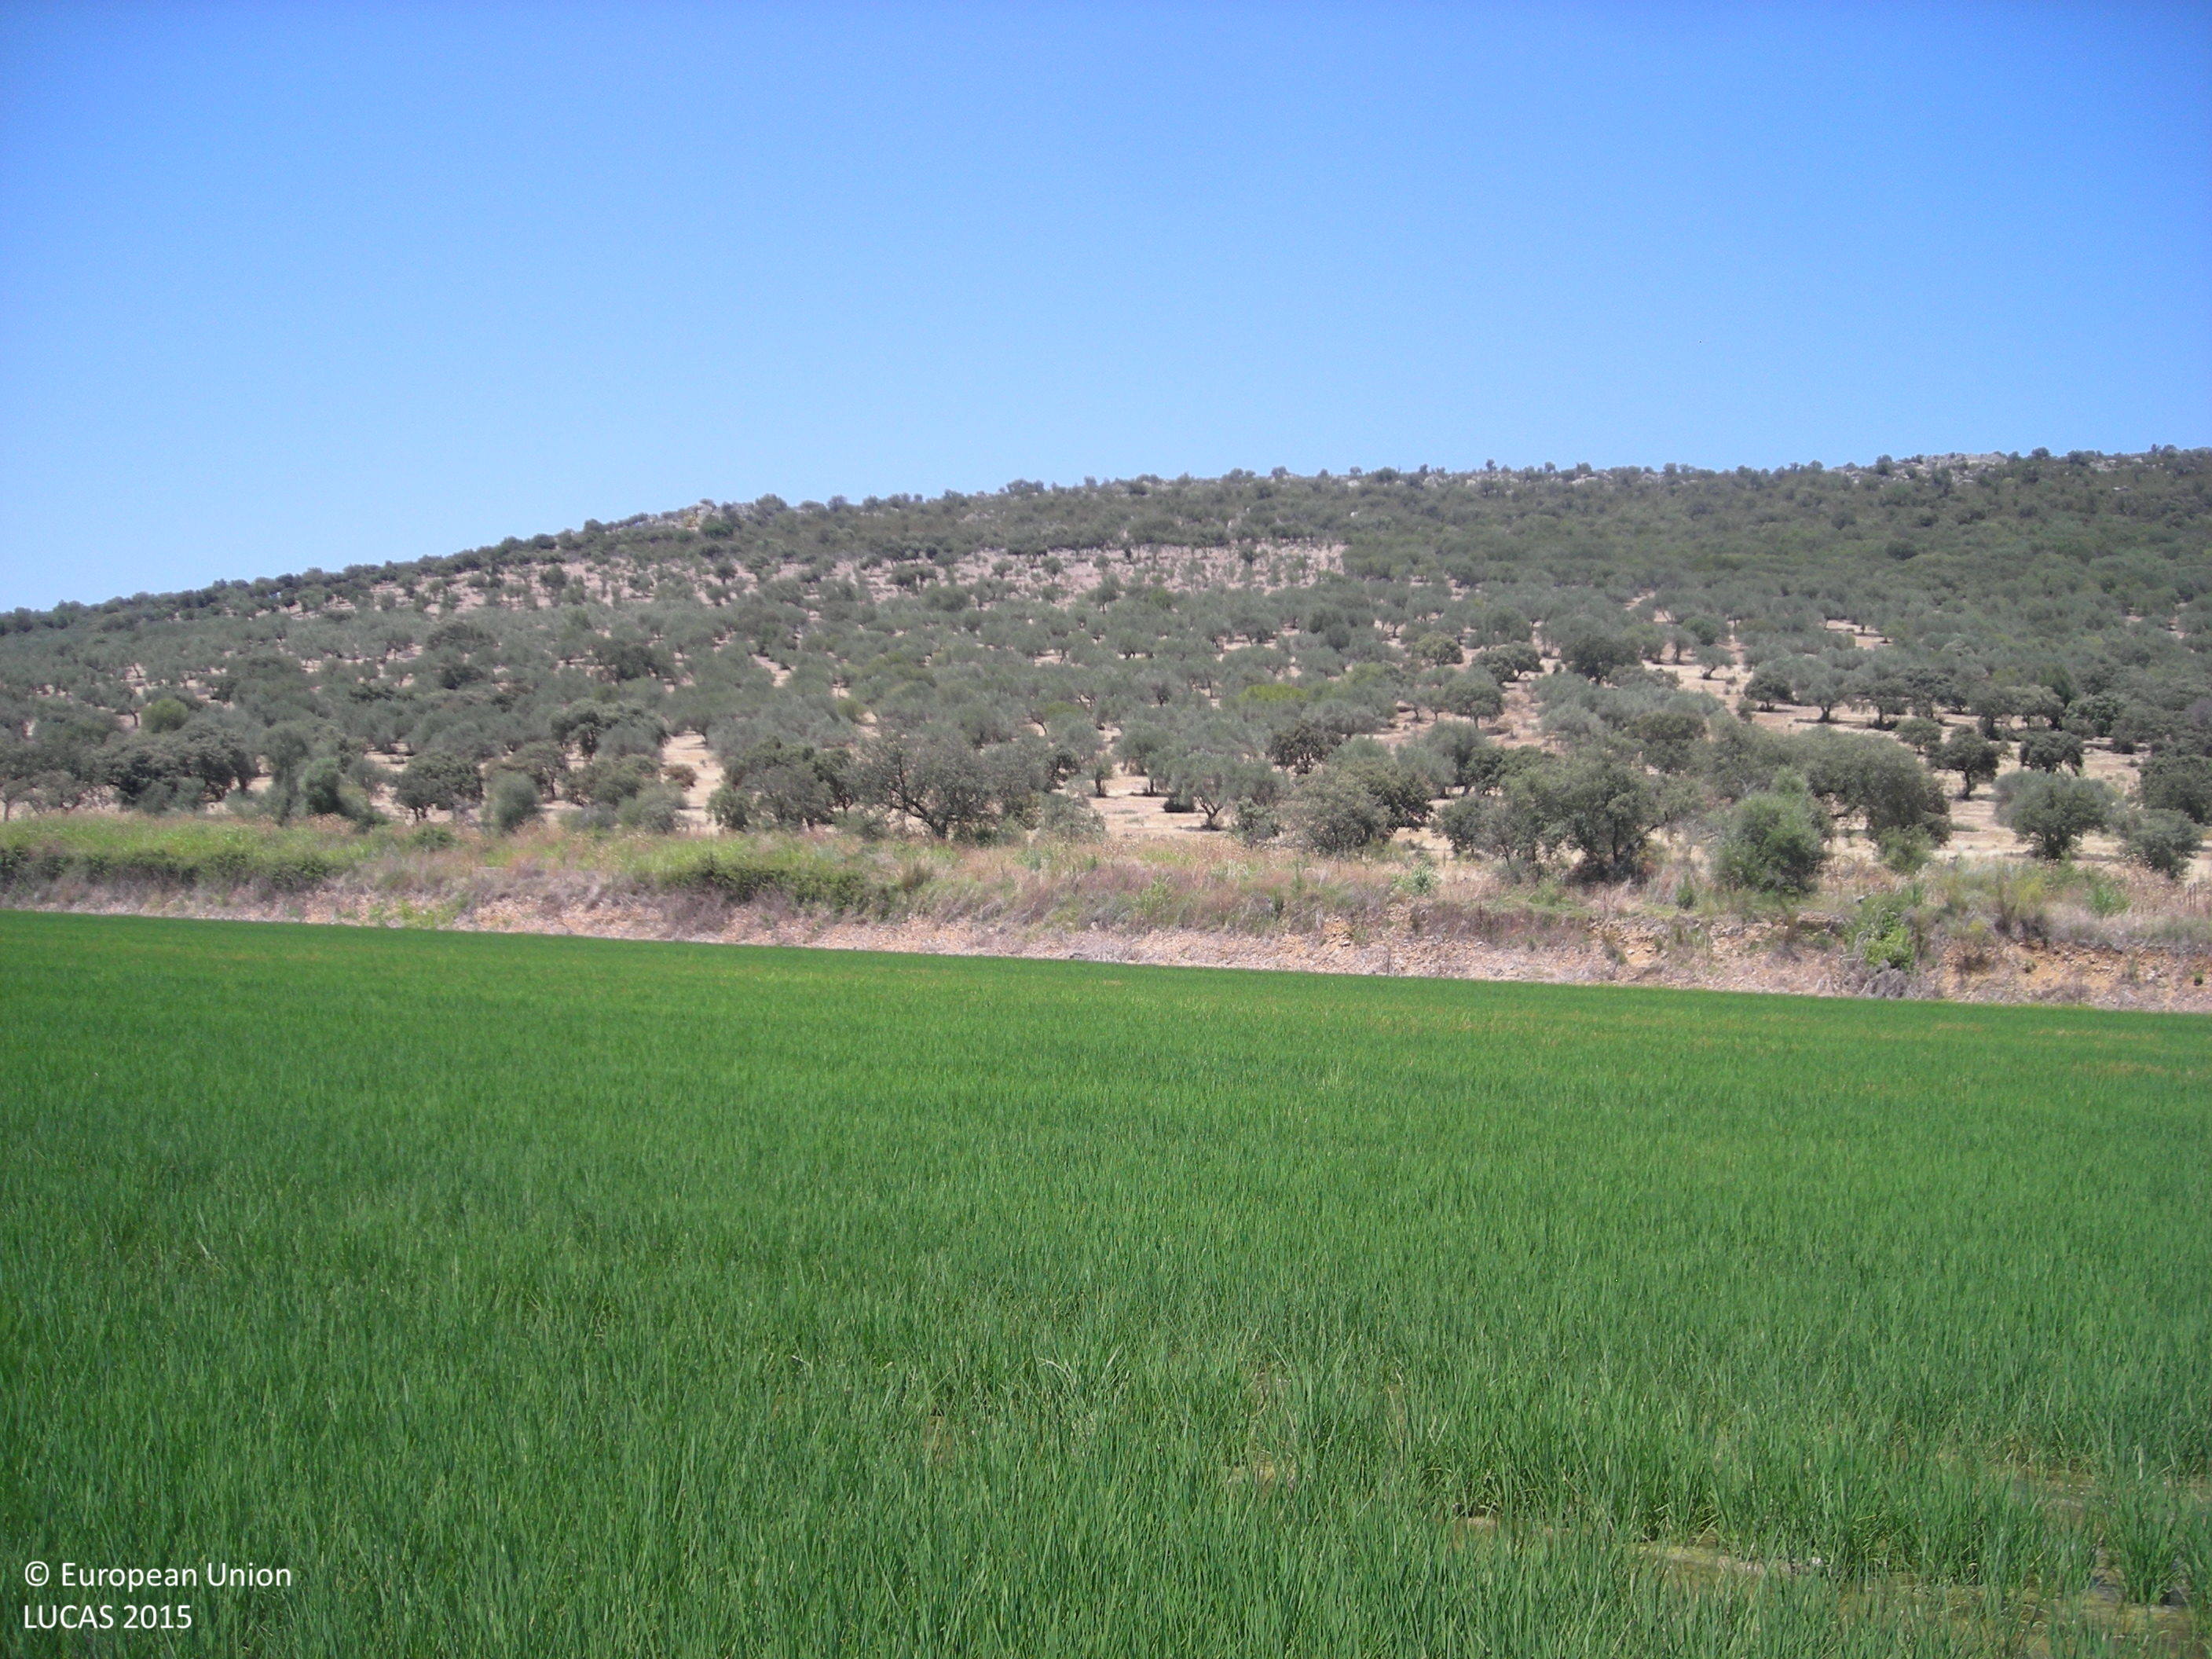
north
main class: Cropland
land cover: Rice
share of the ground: > 75 %
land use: Agriculture (excluding fallow land and kitchen gardens)
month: July
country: ES
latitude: 39.0618
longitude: -5.8490
